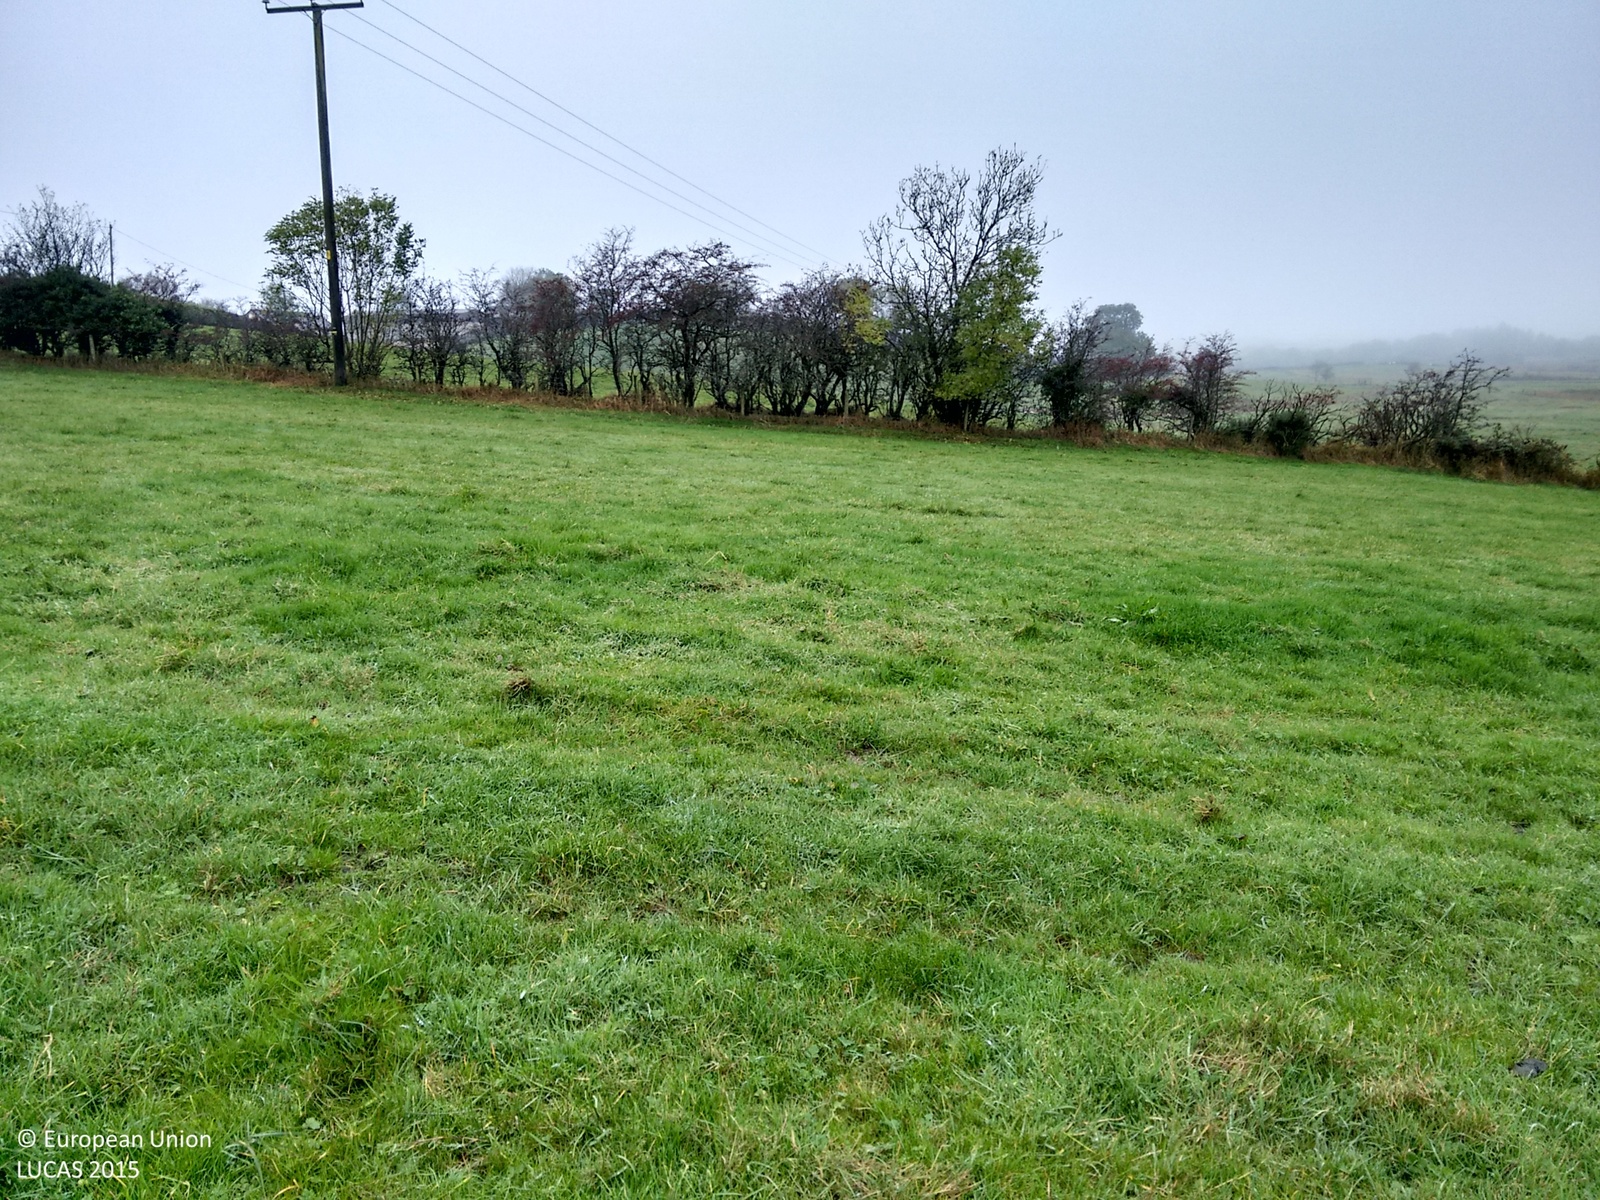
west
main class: Grassland
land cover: Grassland without tree/shrub cover
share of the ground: > 75 %
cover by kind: herbaceous plants 100 %
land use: Agriculture (excluding fallow land and kitchen gardens)
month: October
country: GB
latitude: 54.5222
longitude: -7.5379
